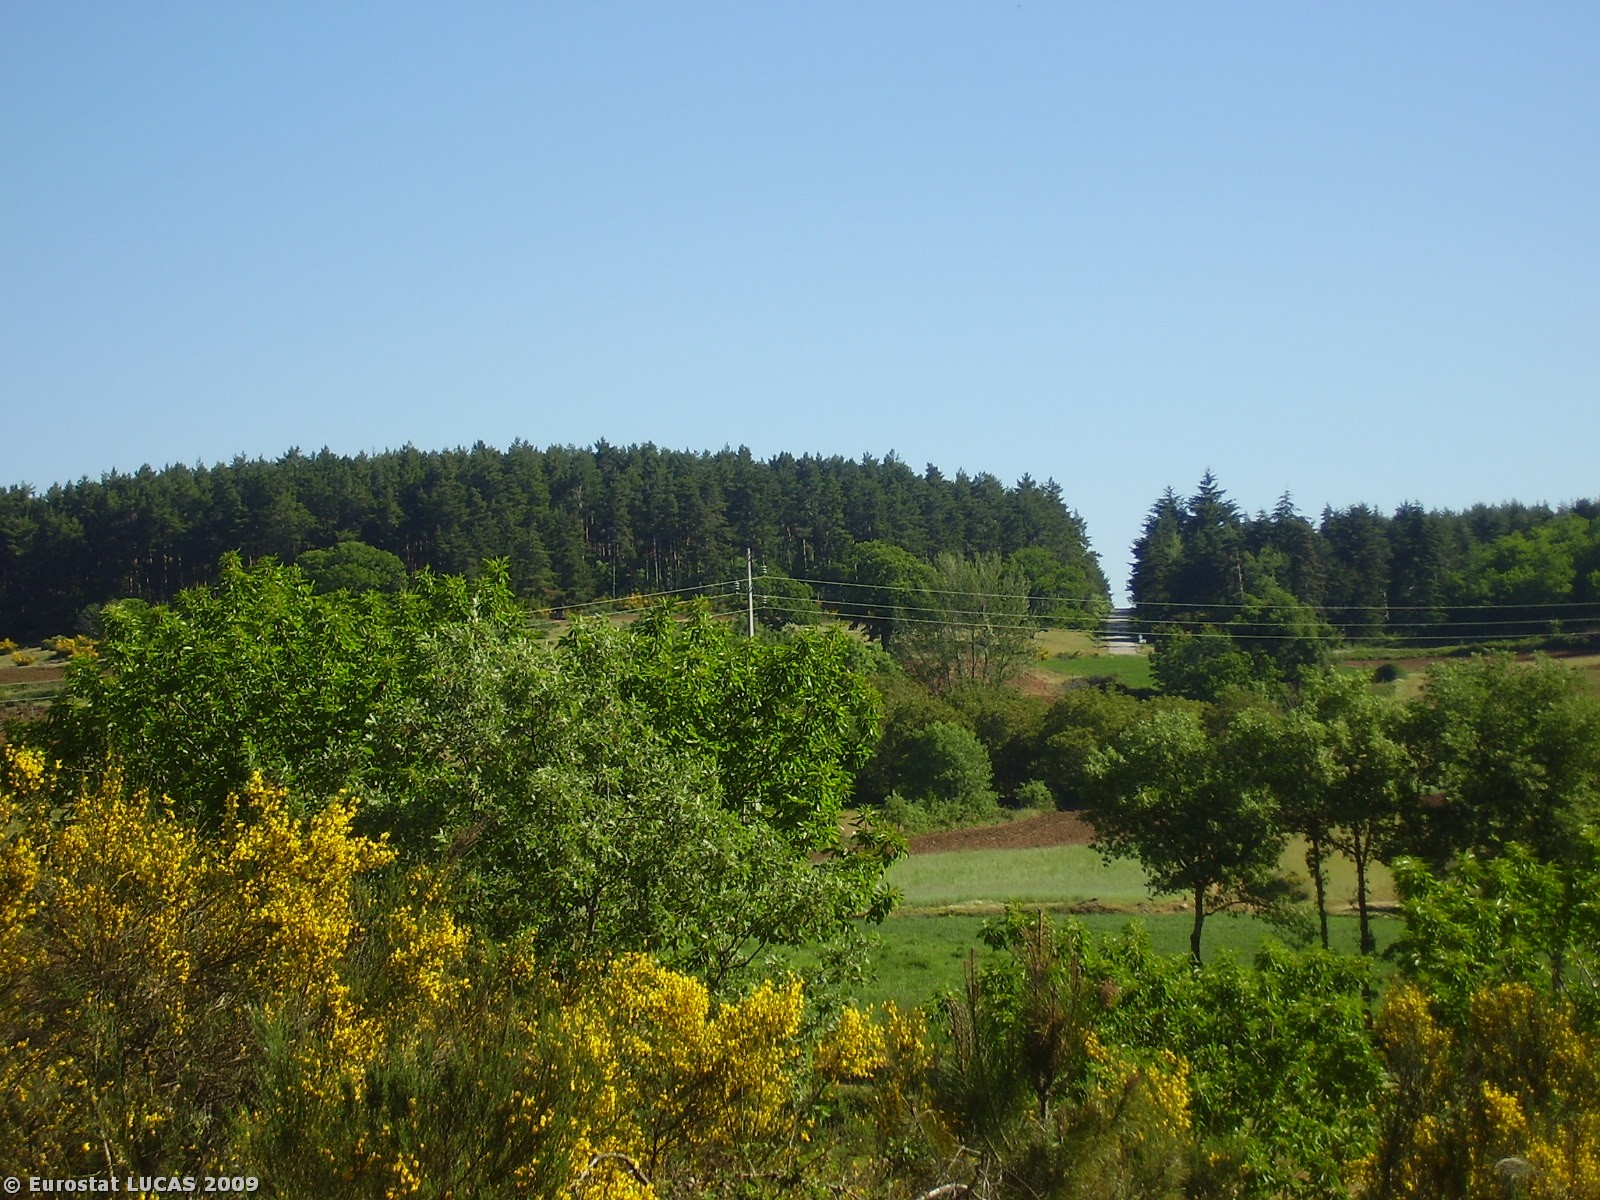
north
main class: Cropland
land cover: Other fruit trees and berries
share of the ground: 10 - 25 %
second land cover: Spontaneously vegetated surfaces
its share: < 10 %
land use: Agriculture (excluding fallow land and kitchen gardens)
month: June
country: PT
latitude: 41.7528
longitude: -6.9171
